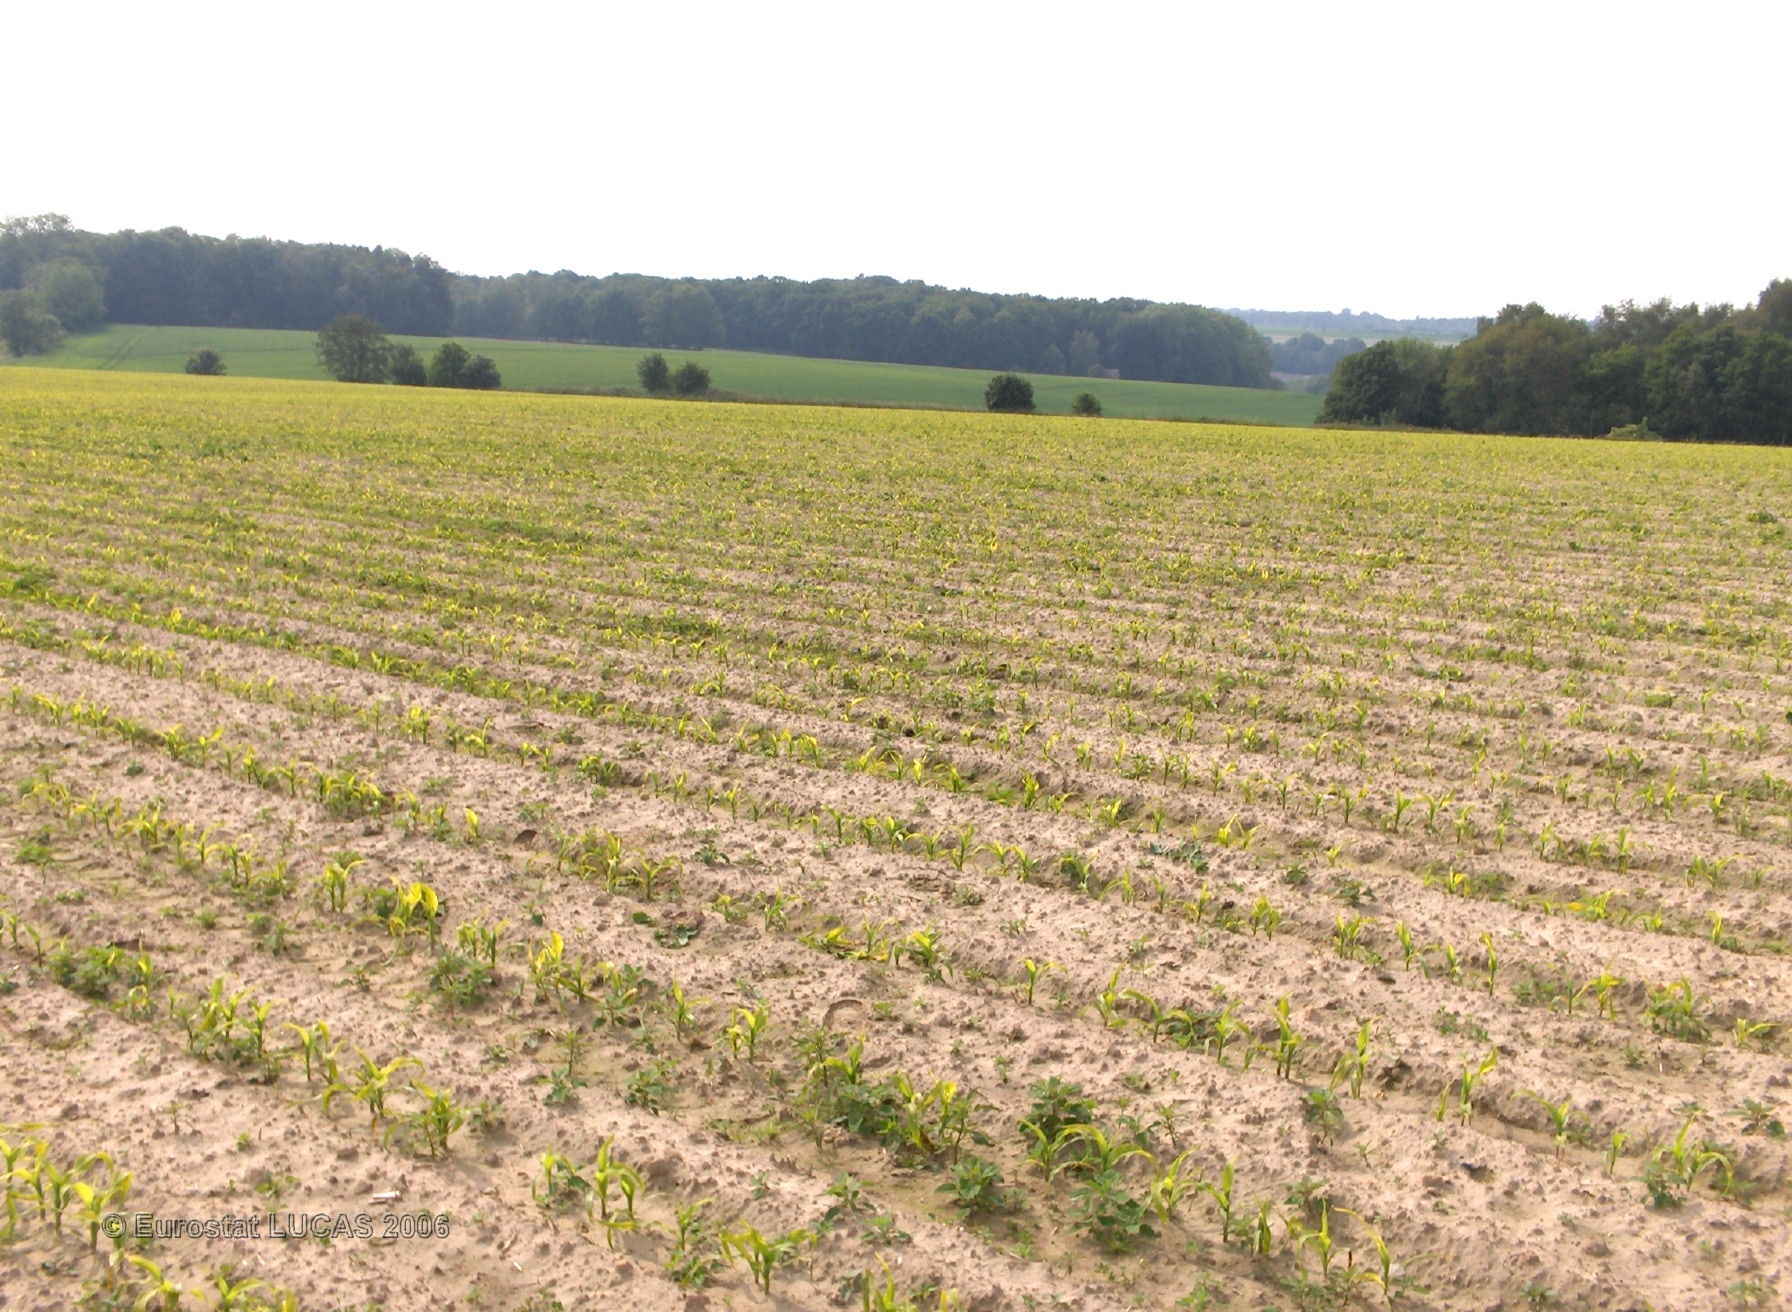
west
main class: Cropland
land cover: Maize
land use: Agriculture (excluding fallow land and kitchen gardens)
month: May
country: BE
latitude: 50.6115
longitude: 4.5269
